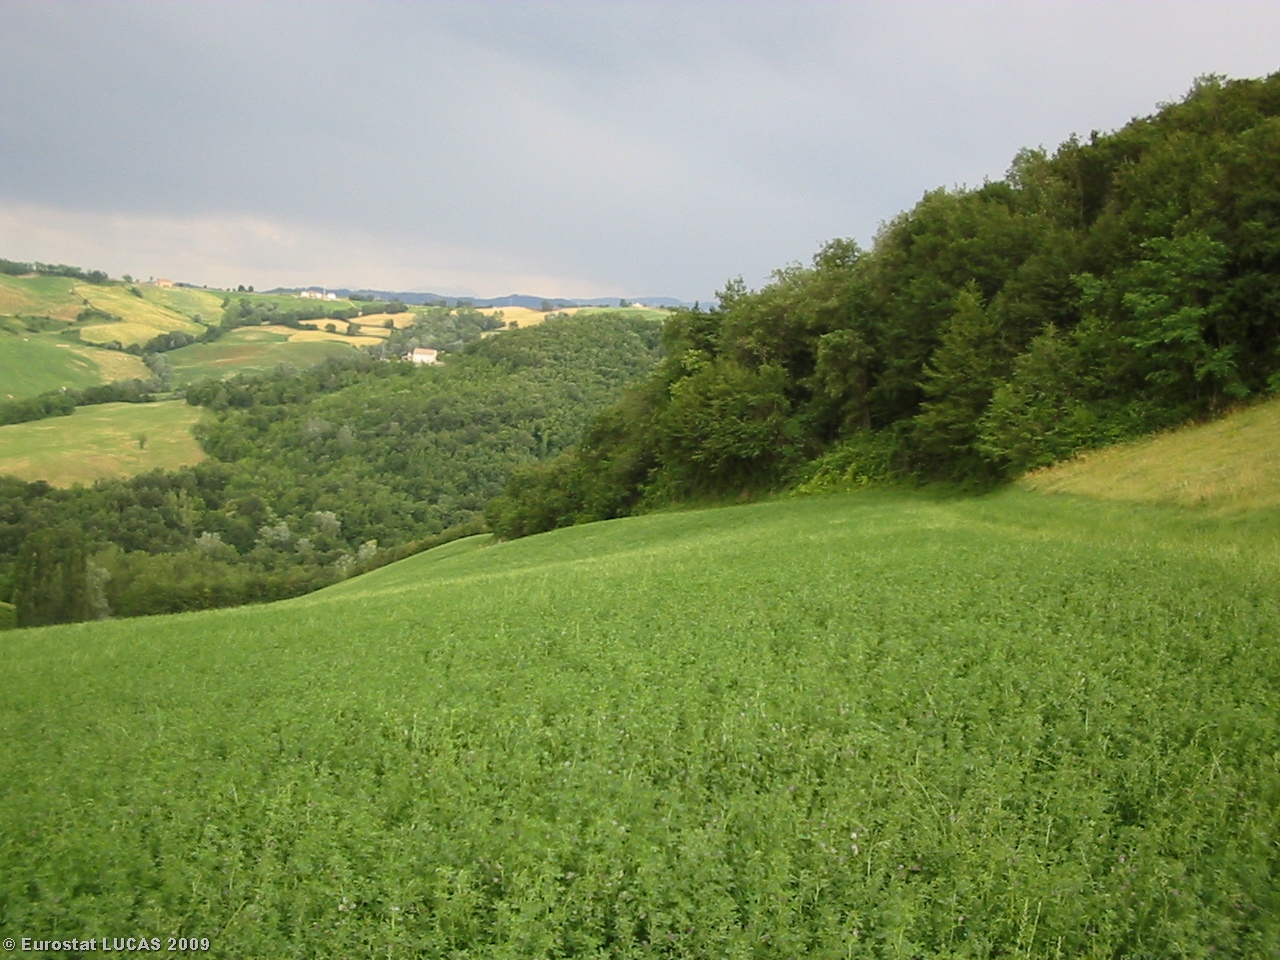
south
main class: Cropland
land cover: Lucerne
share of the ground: > 75 %
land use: Agriculture (excluding fallow land and kitchen gardens)
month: June
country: IT
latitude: 44.6569
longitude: 10.2391
